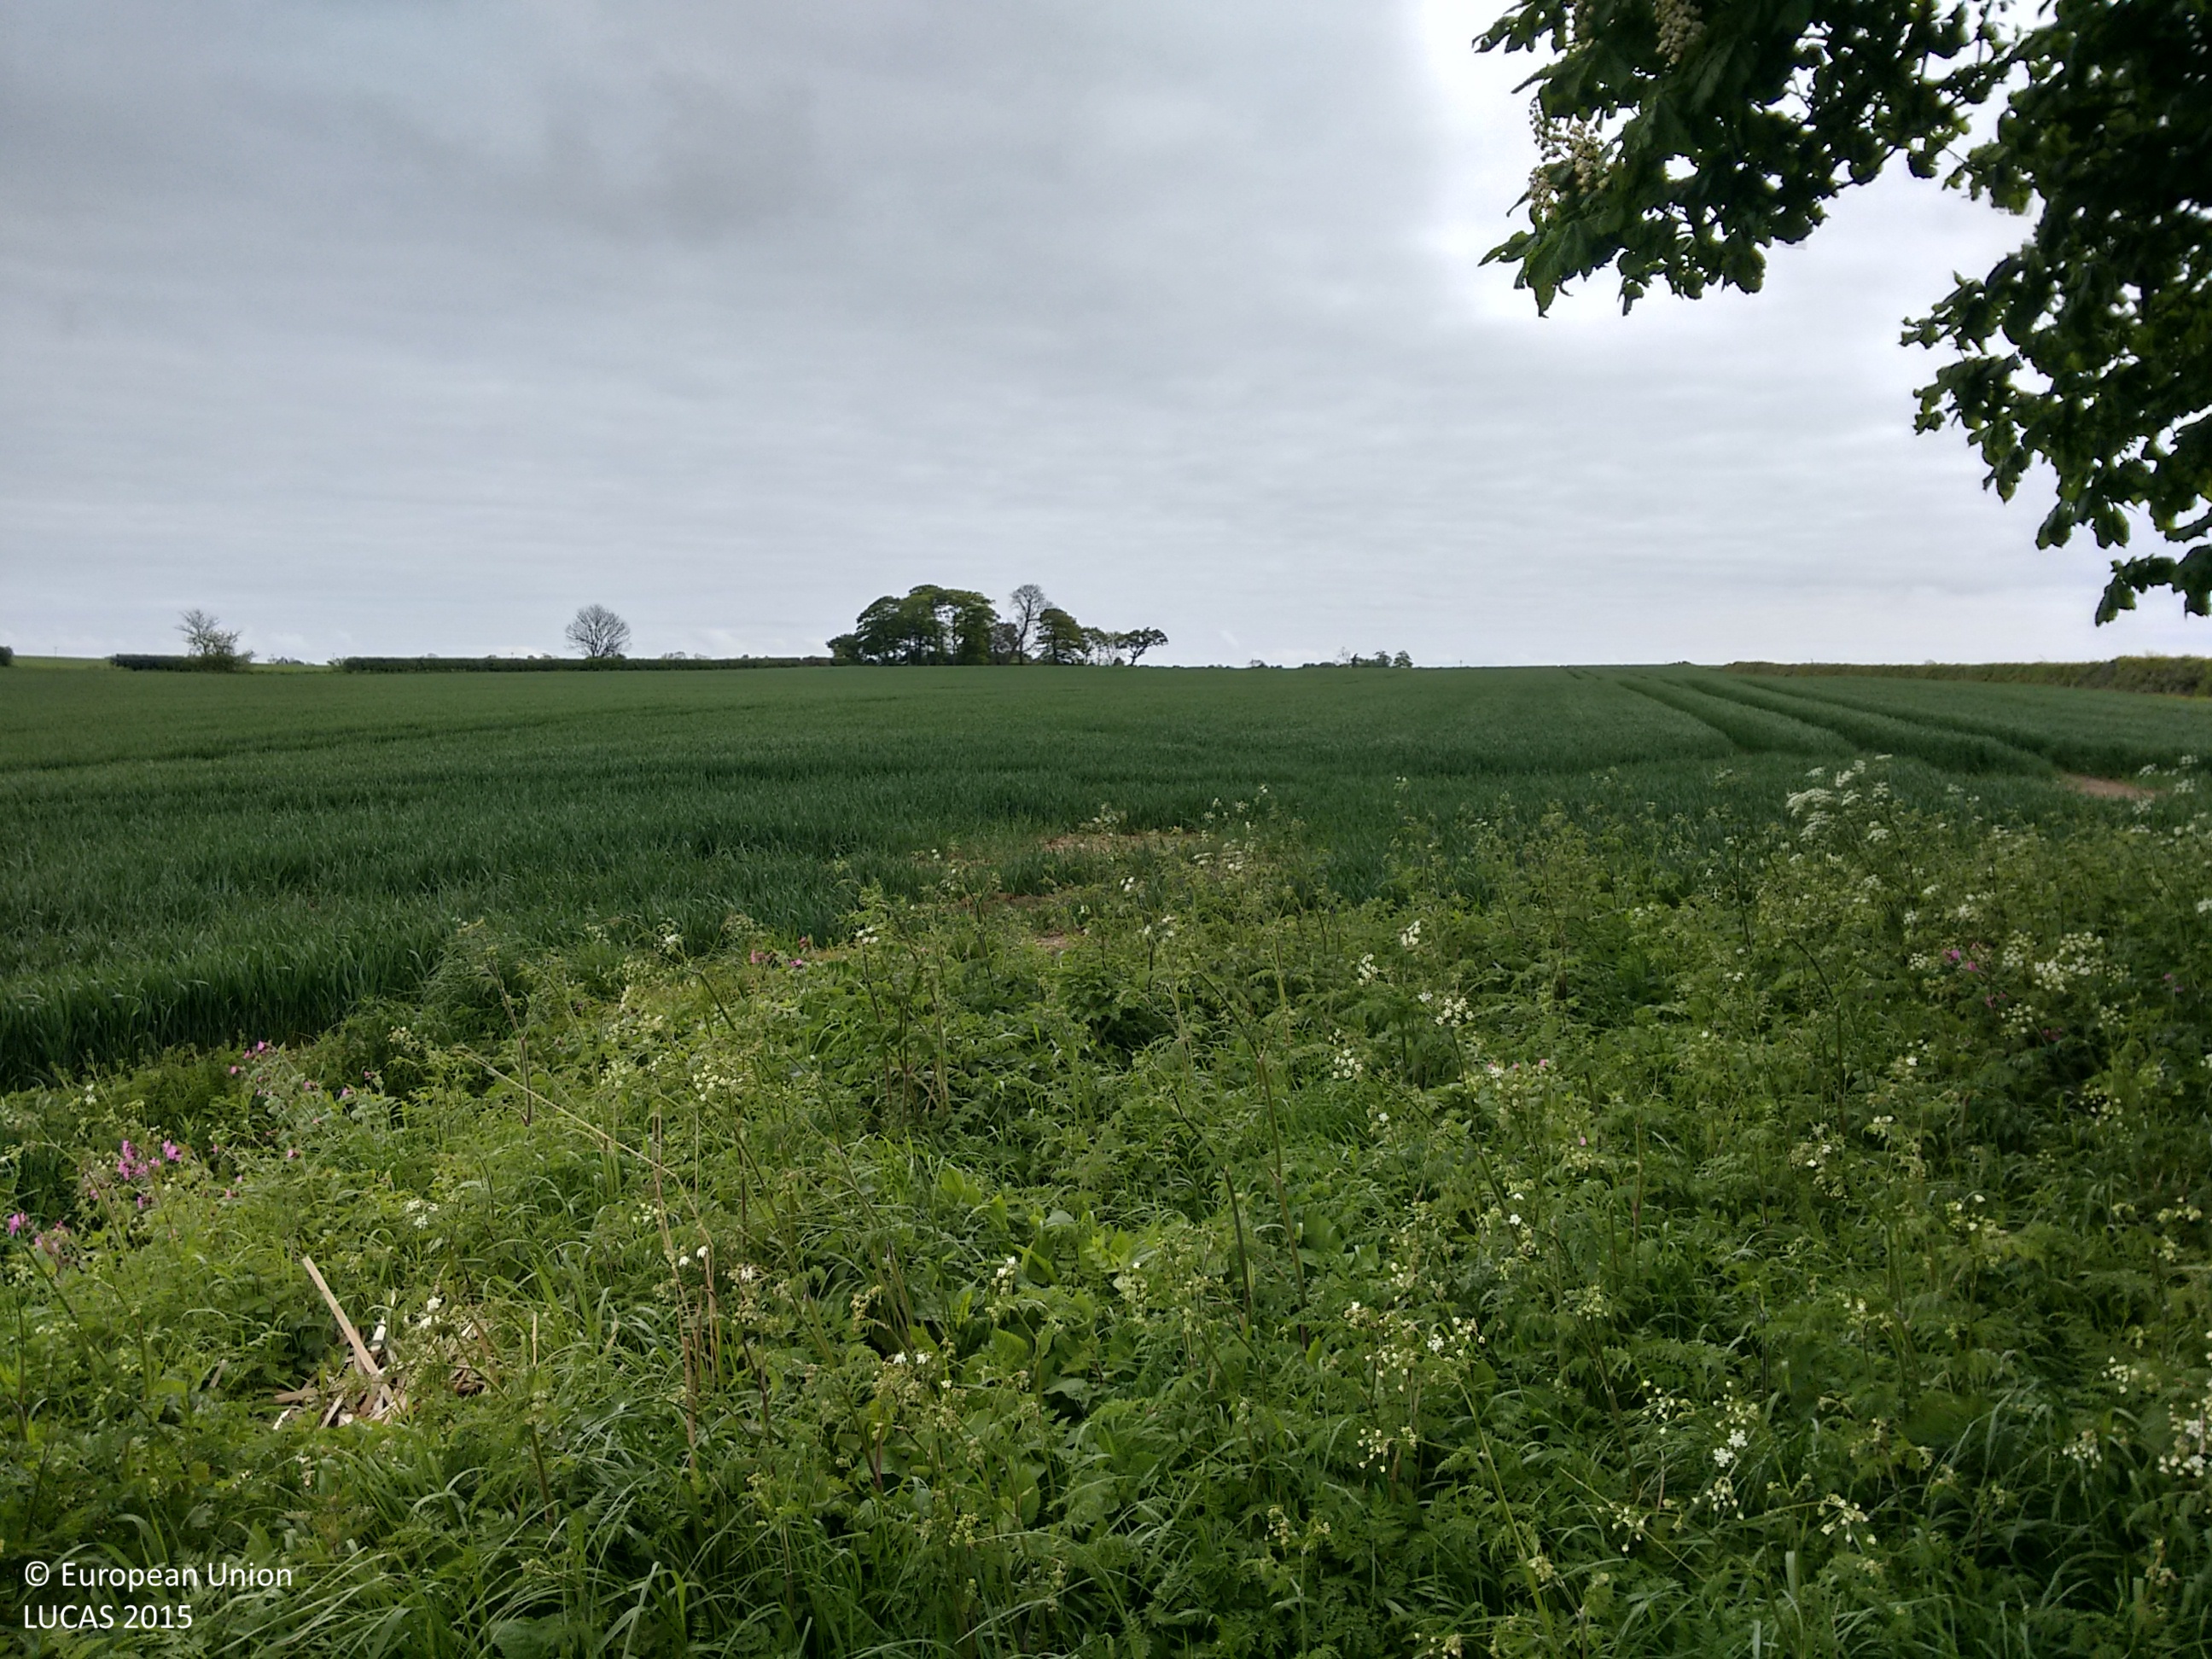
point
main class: Cropland
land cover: Common wheat
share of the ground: > 75 %
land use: Agriculture (excluding fallow land and kitchen gardens)
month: May
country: GB
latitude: 53.7919
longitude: -0.1274
